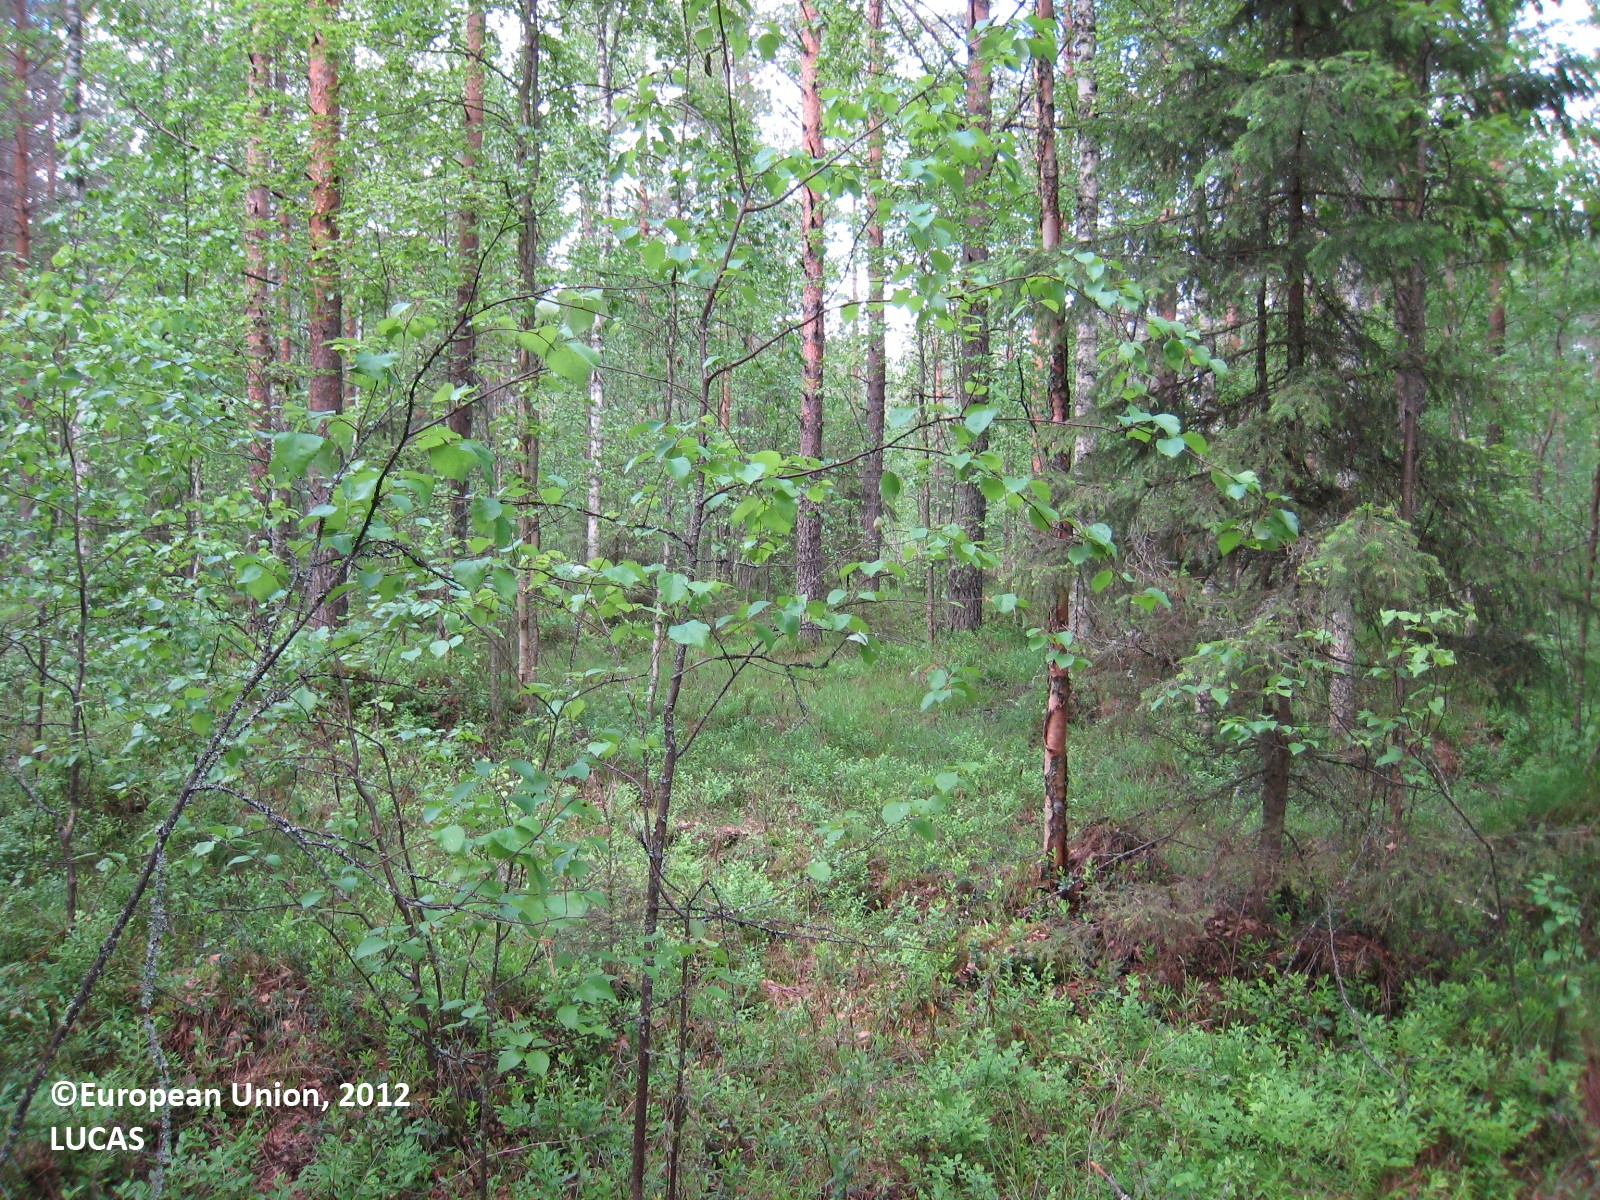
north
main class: Woodland
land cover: Pine dominated mixed woodland
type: boreal forest
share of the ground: 50 - 75 %
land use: Forestry
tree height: > 5 m
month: June
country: FI
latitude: 62.4895
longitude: 25.9782
